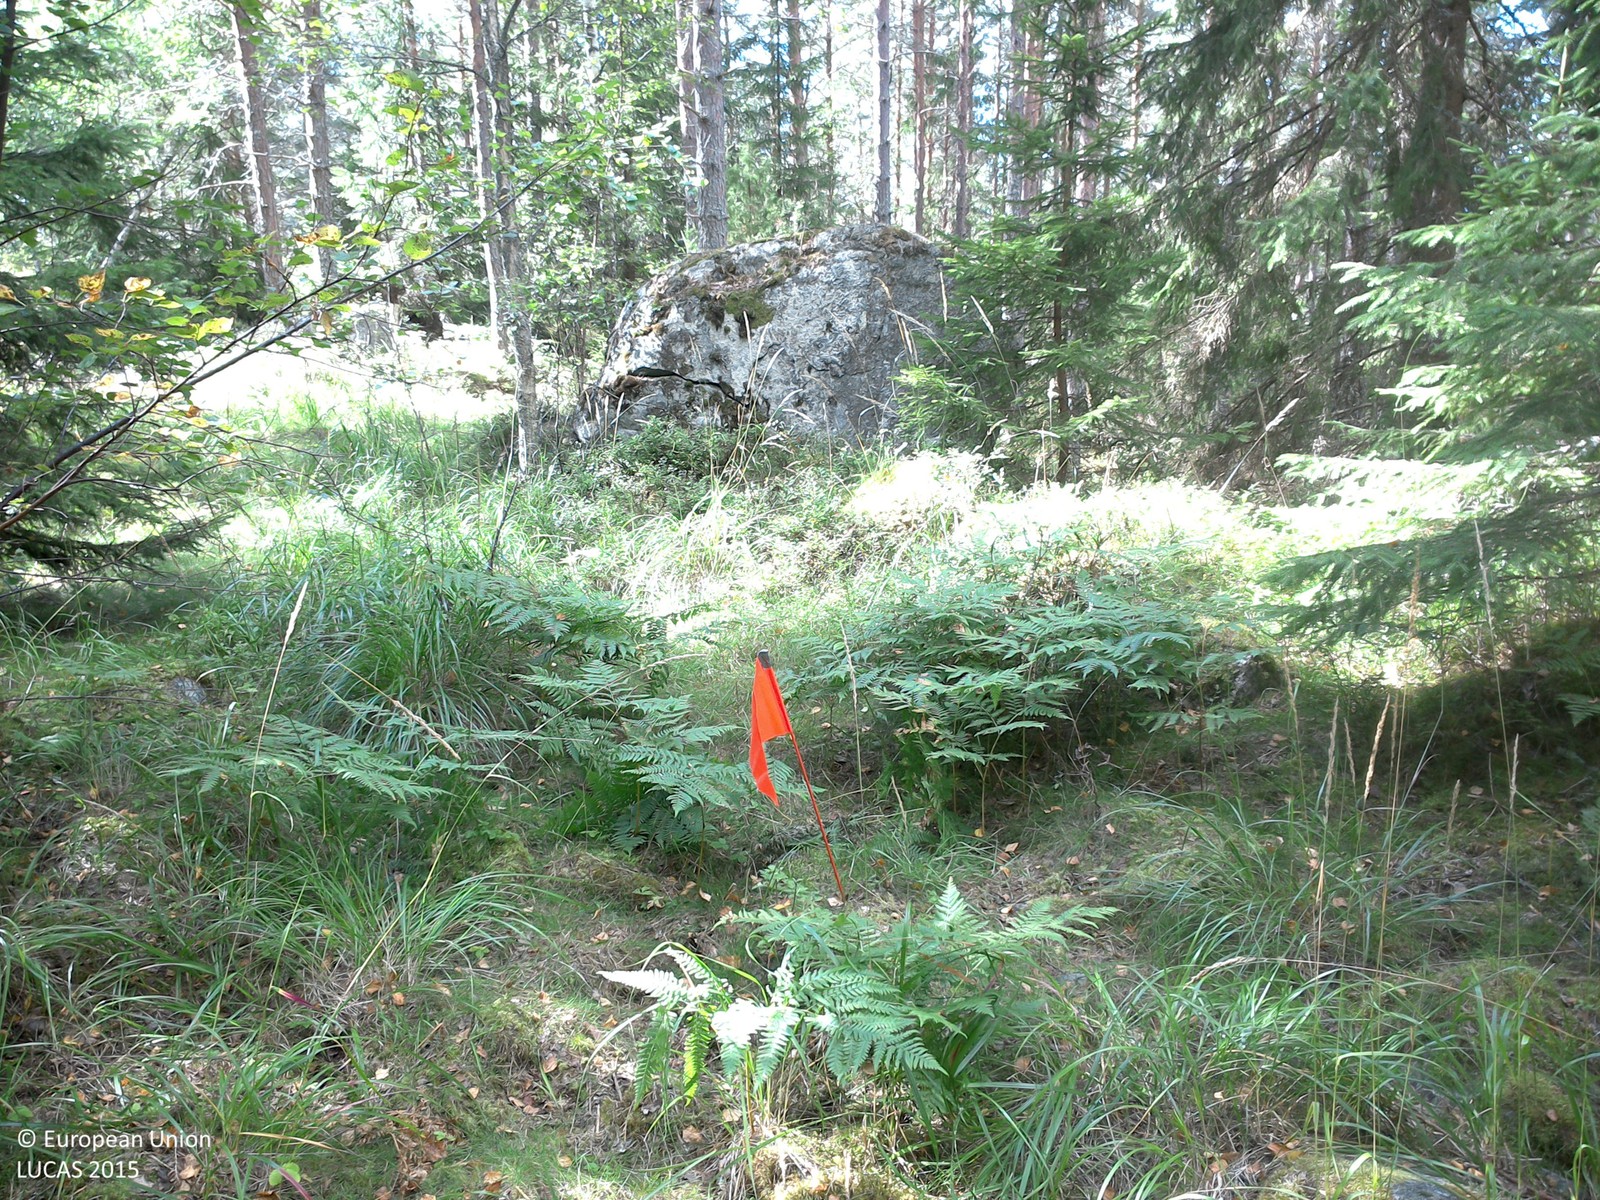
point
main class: Woodland
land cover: Spruce dominated mixed woodland
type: boreal forest
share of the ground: > 75 %
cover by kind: coniferous forest trees 45 %, herbaceous plants 25 %, broadleaved forest trees 20 %, shrubs 5 %, lichens and mosses 5 %
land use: Forestry
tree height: > 5 m
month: August
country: SE
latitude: 58.0789
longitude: 15.3025
